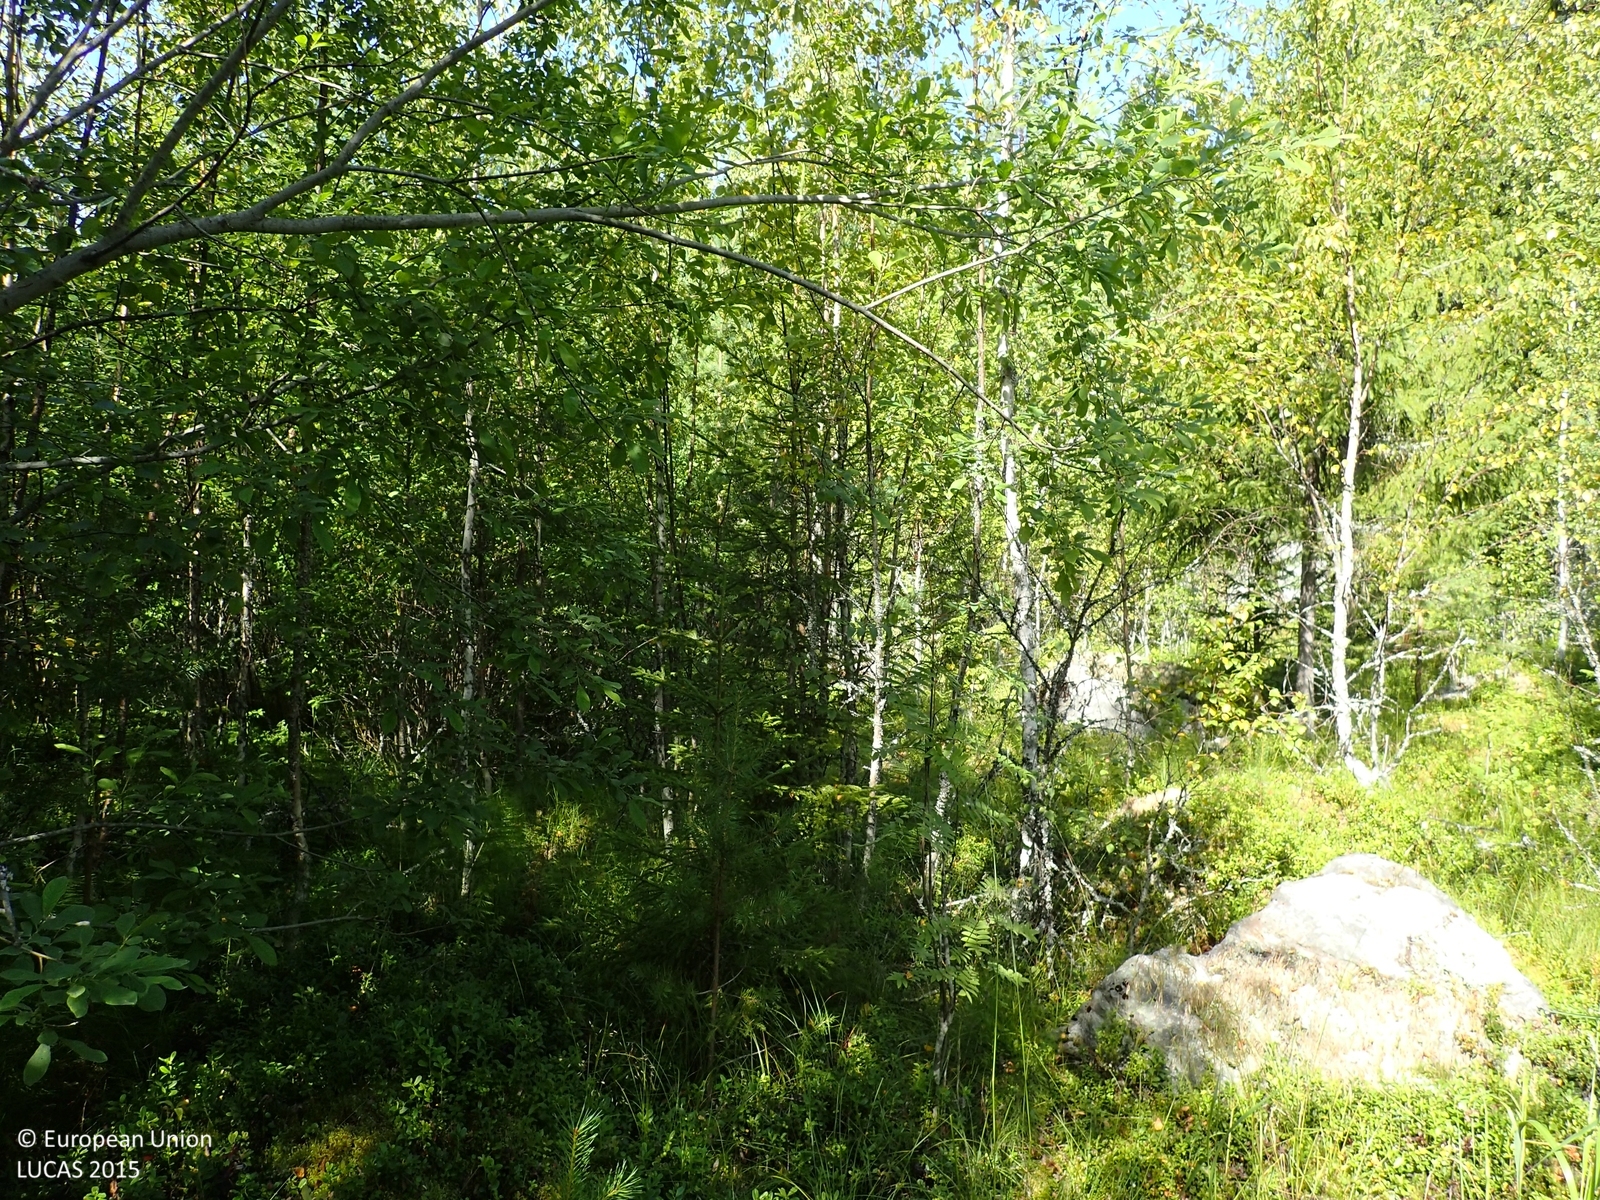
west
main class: Woodland
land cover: Broadleaved woodland
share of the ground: > 75 %
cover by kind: broadleaved forest trees 65 %, coniferous forest trees 10 %, shrubs 10 %, herbaceous plants 10 %, lichens and mosses 5 %
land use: Forestry
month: August
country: FI
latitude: 62.9438
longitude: 21.8875
